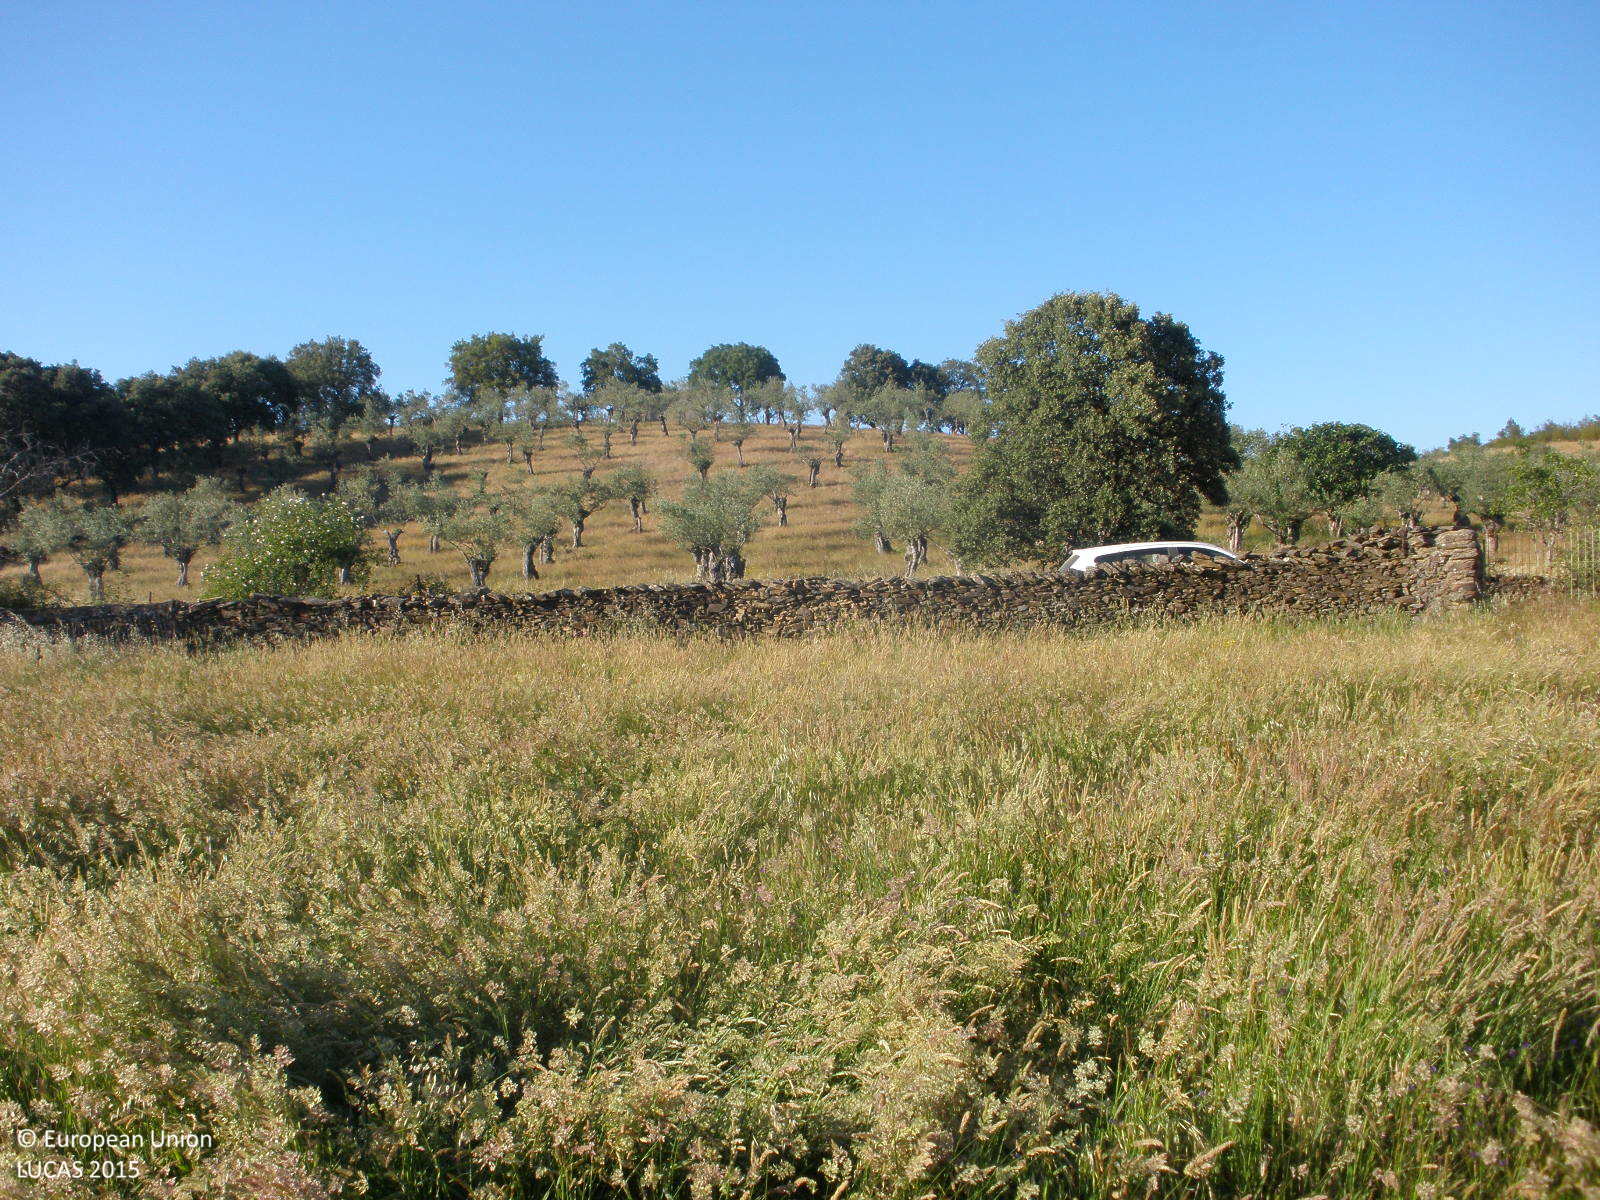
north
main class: Grassland
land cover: Spontaneously vegetated surfaces
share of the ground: > 75 %
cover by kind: herbaceous plants 100 %
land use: Fallow land
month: May
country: ES
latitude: 40.2337
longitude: -6.2147
